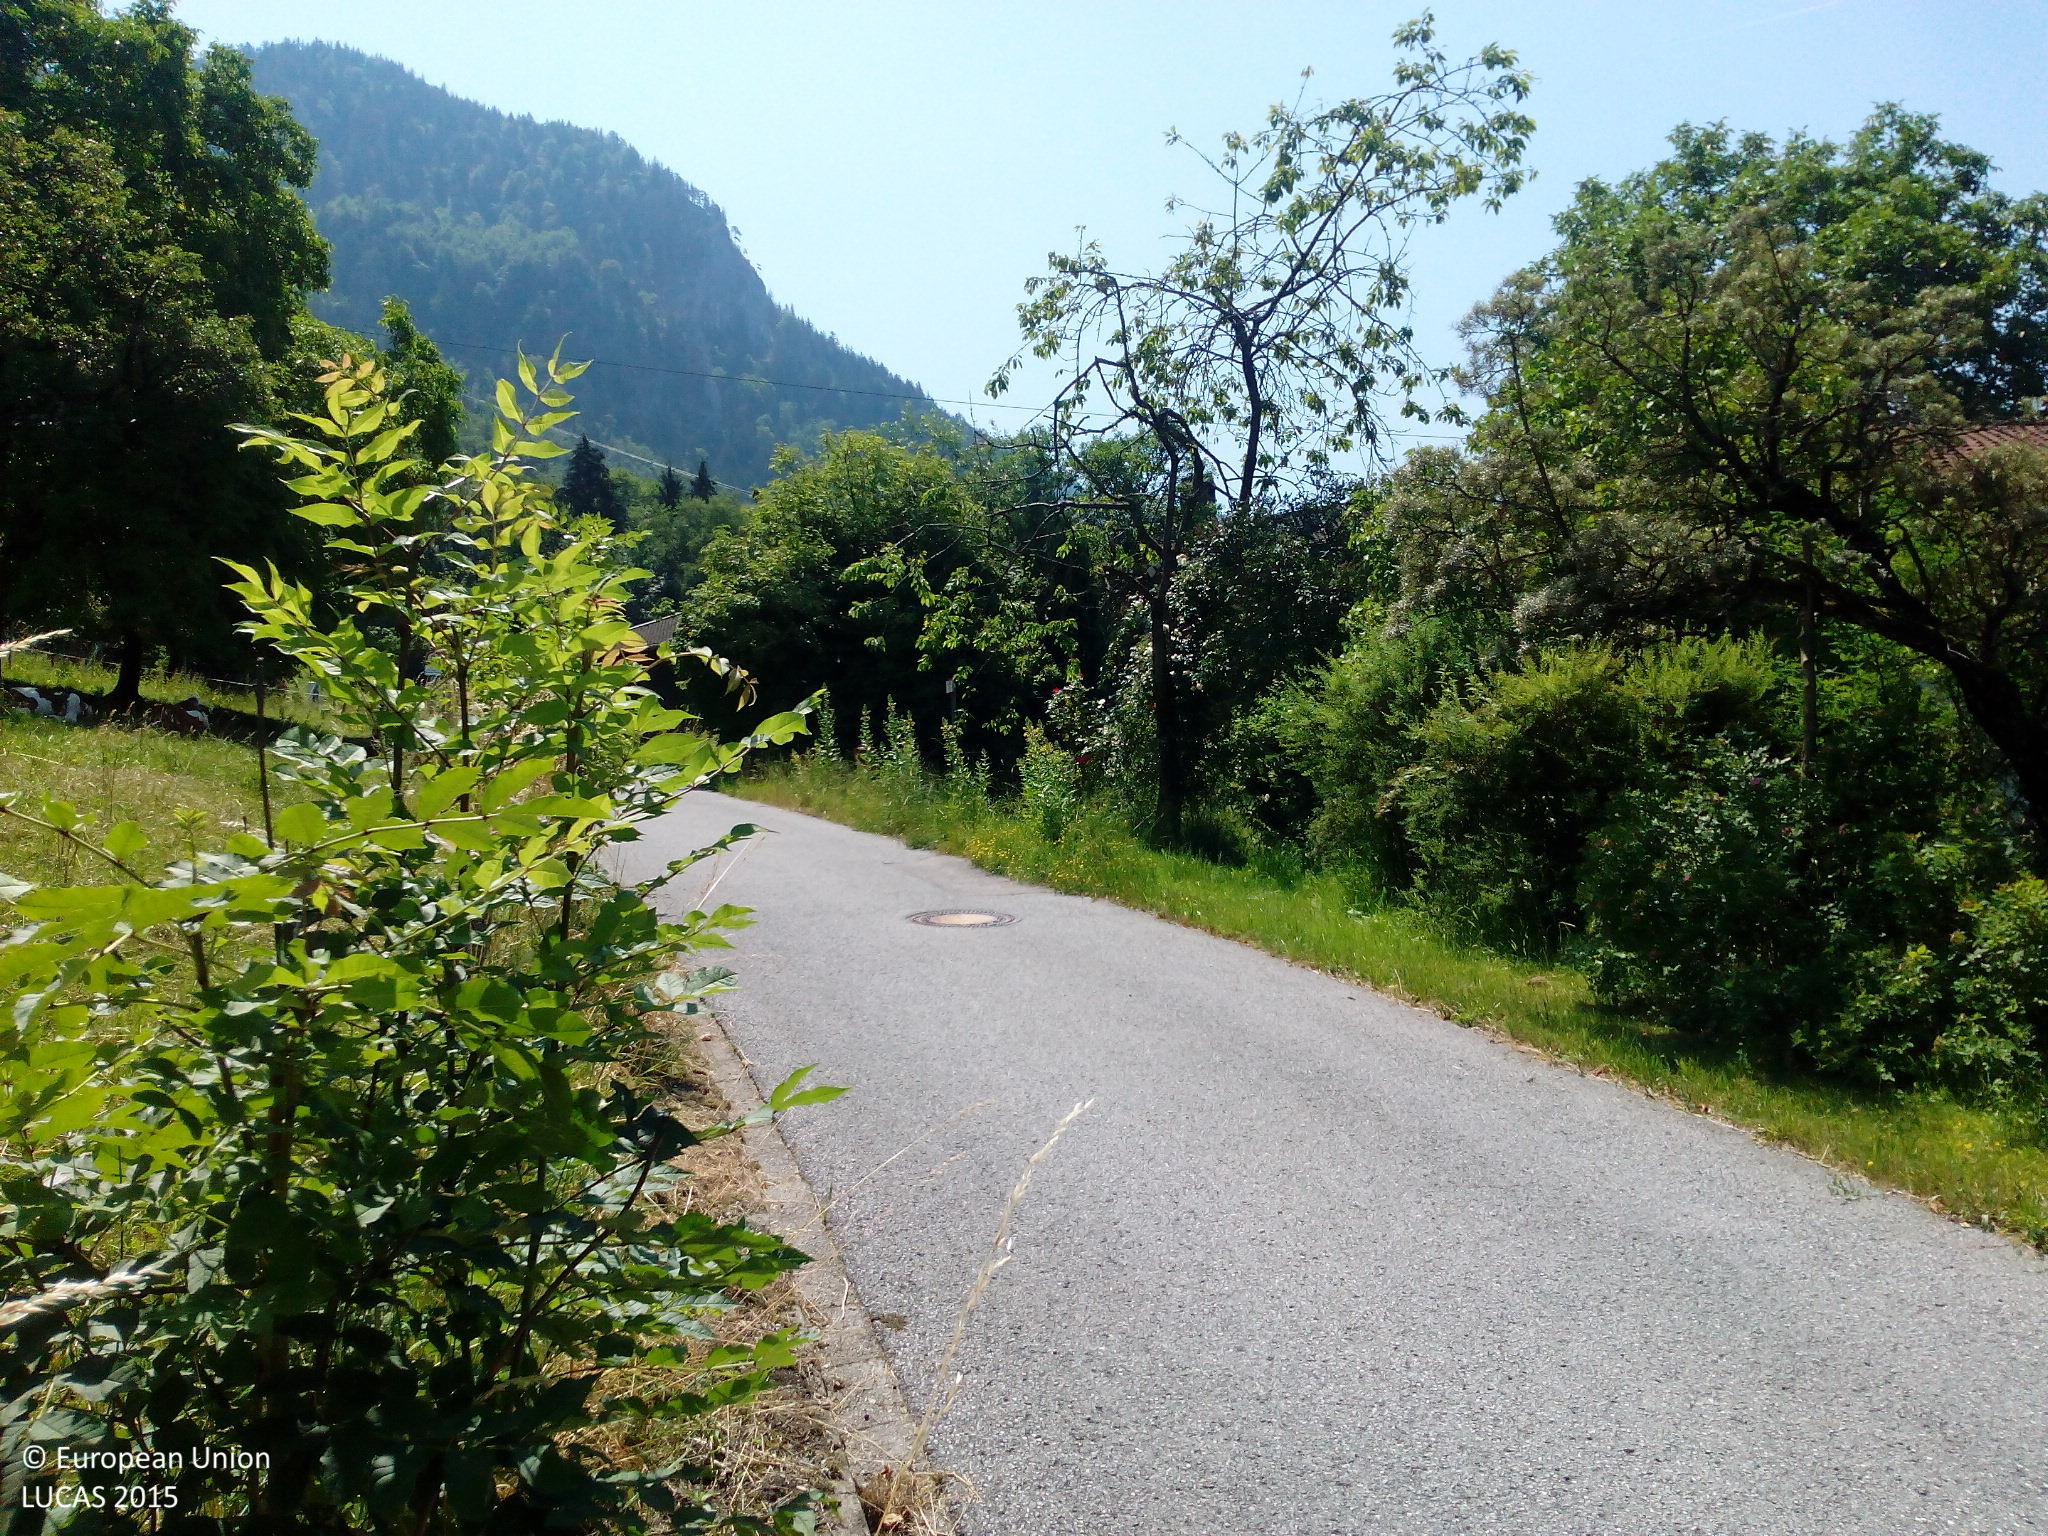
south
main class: Grassland
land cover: Grassland without tree/shrub cover
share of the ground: > 75 %
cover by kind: herbaceous plants 100 %
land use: Agriculture (excluding fallow land and kitchen gardens)
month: July
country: DE
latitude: 47.7668
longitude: 12.3336
